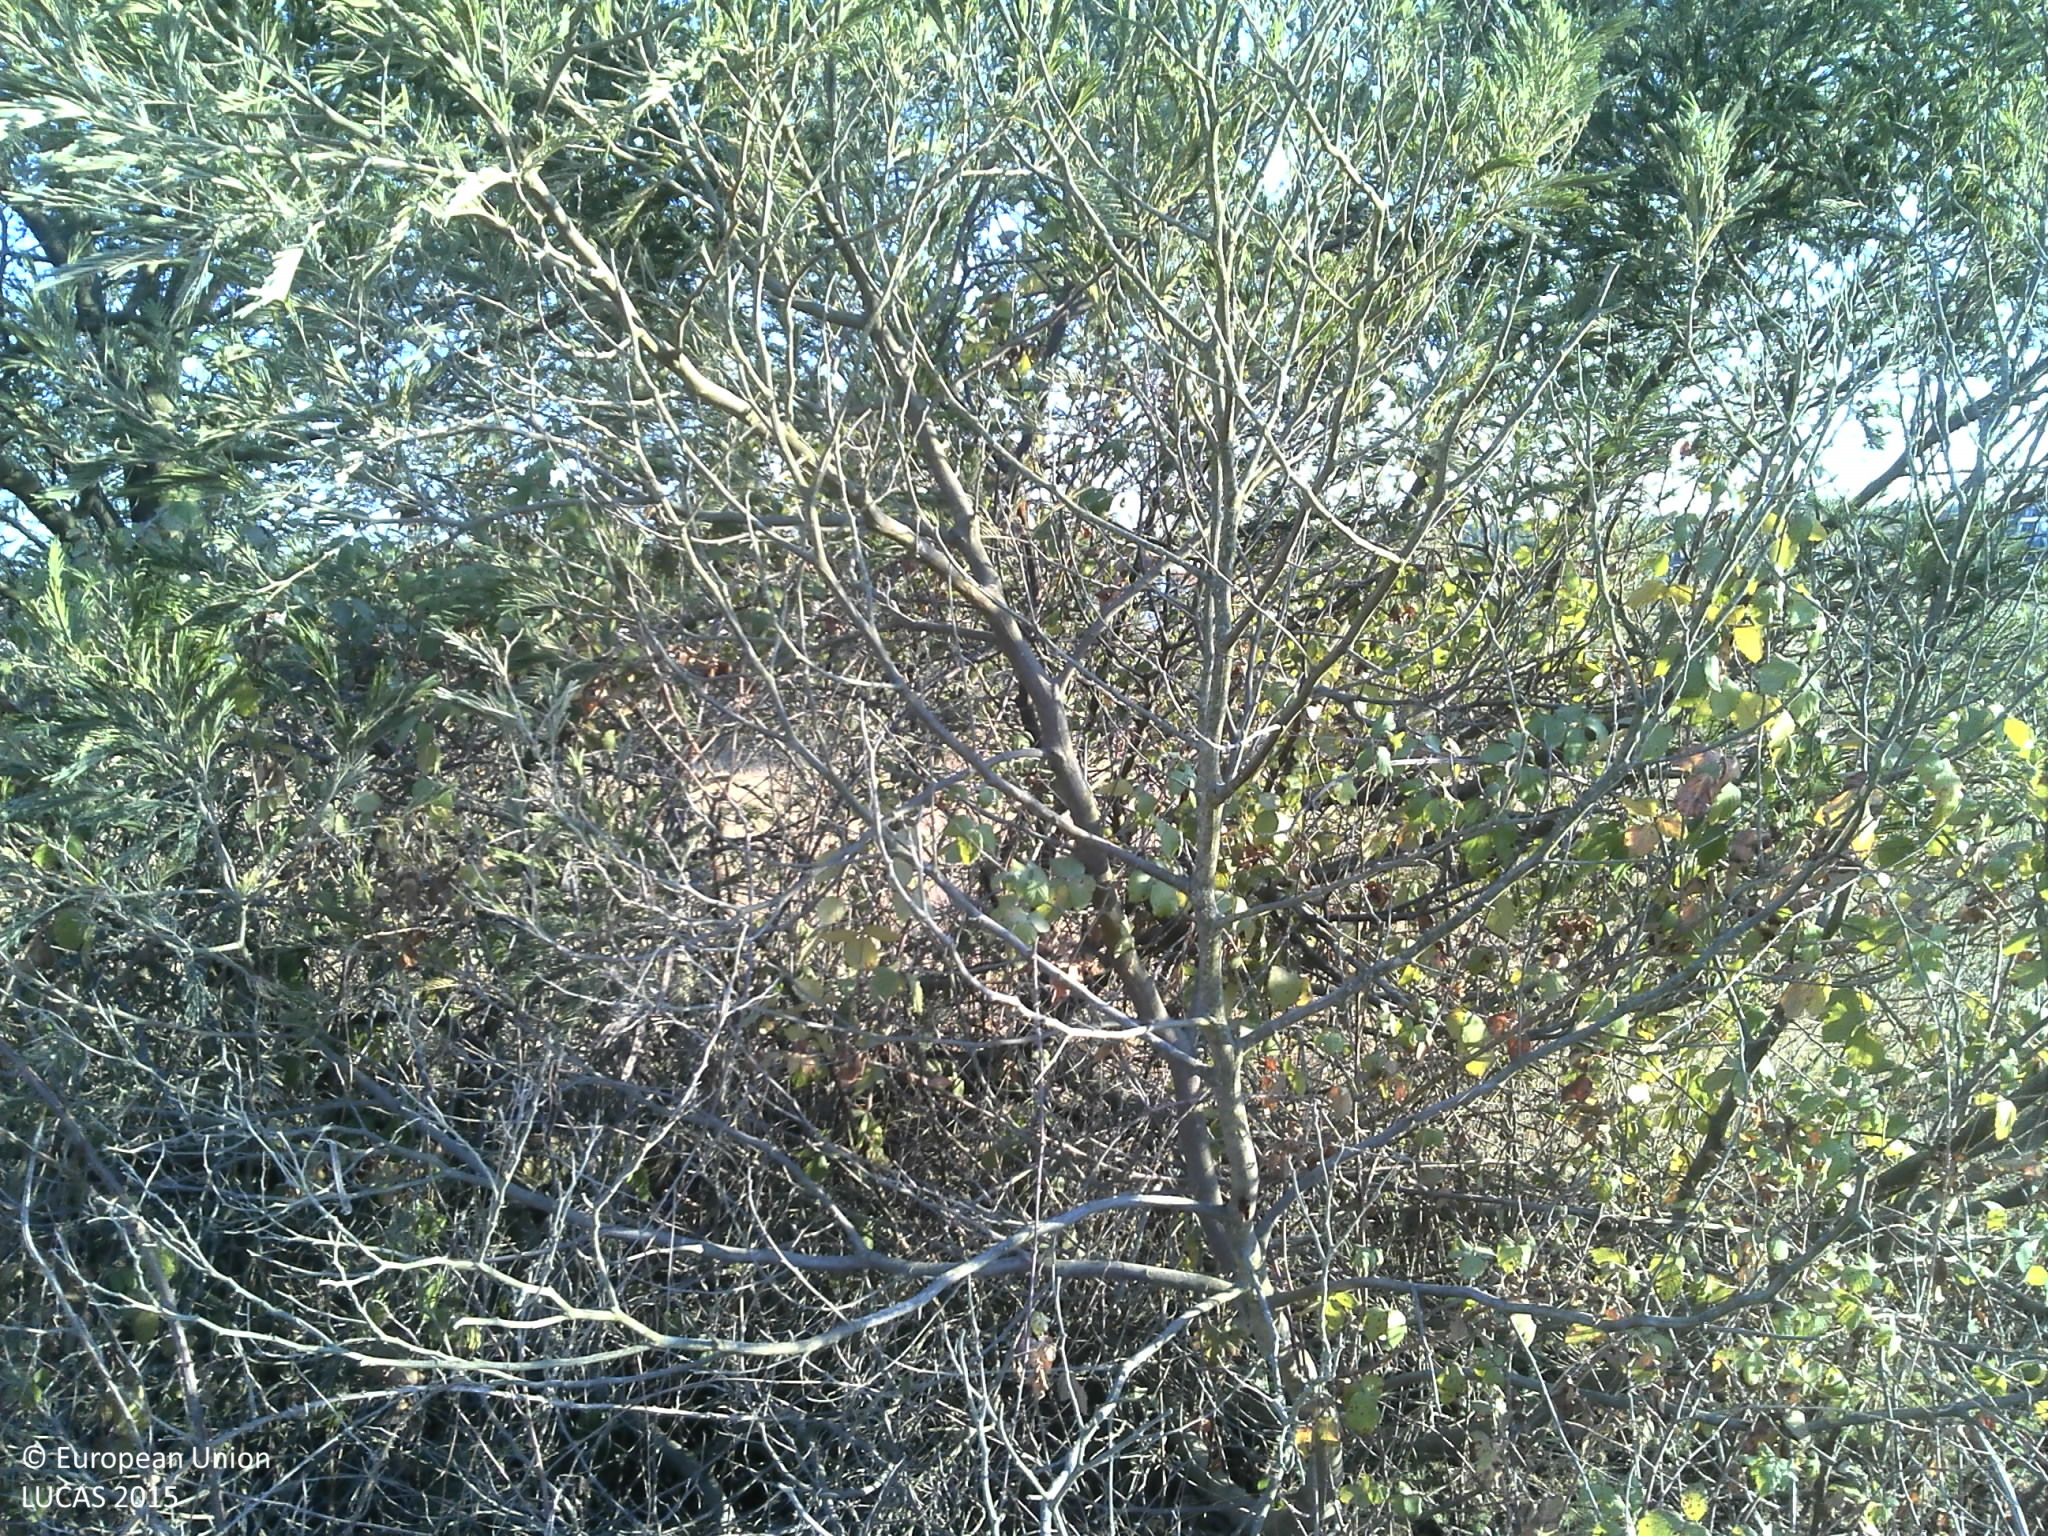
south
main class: Grassland
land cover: Spontaneously vegetated surfaces
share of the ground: > 75 %
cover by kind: herbaceous plants 90 %, unconsolidated bare surface 10 %
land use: Fallow land
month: August
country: PT
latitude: 38.6571
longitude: -8.5943
